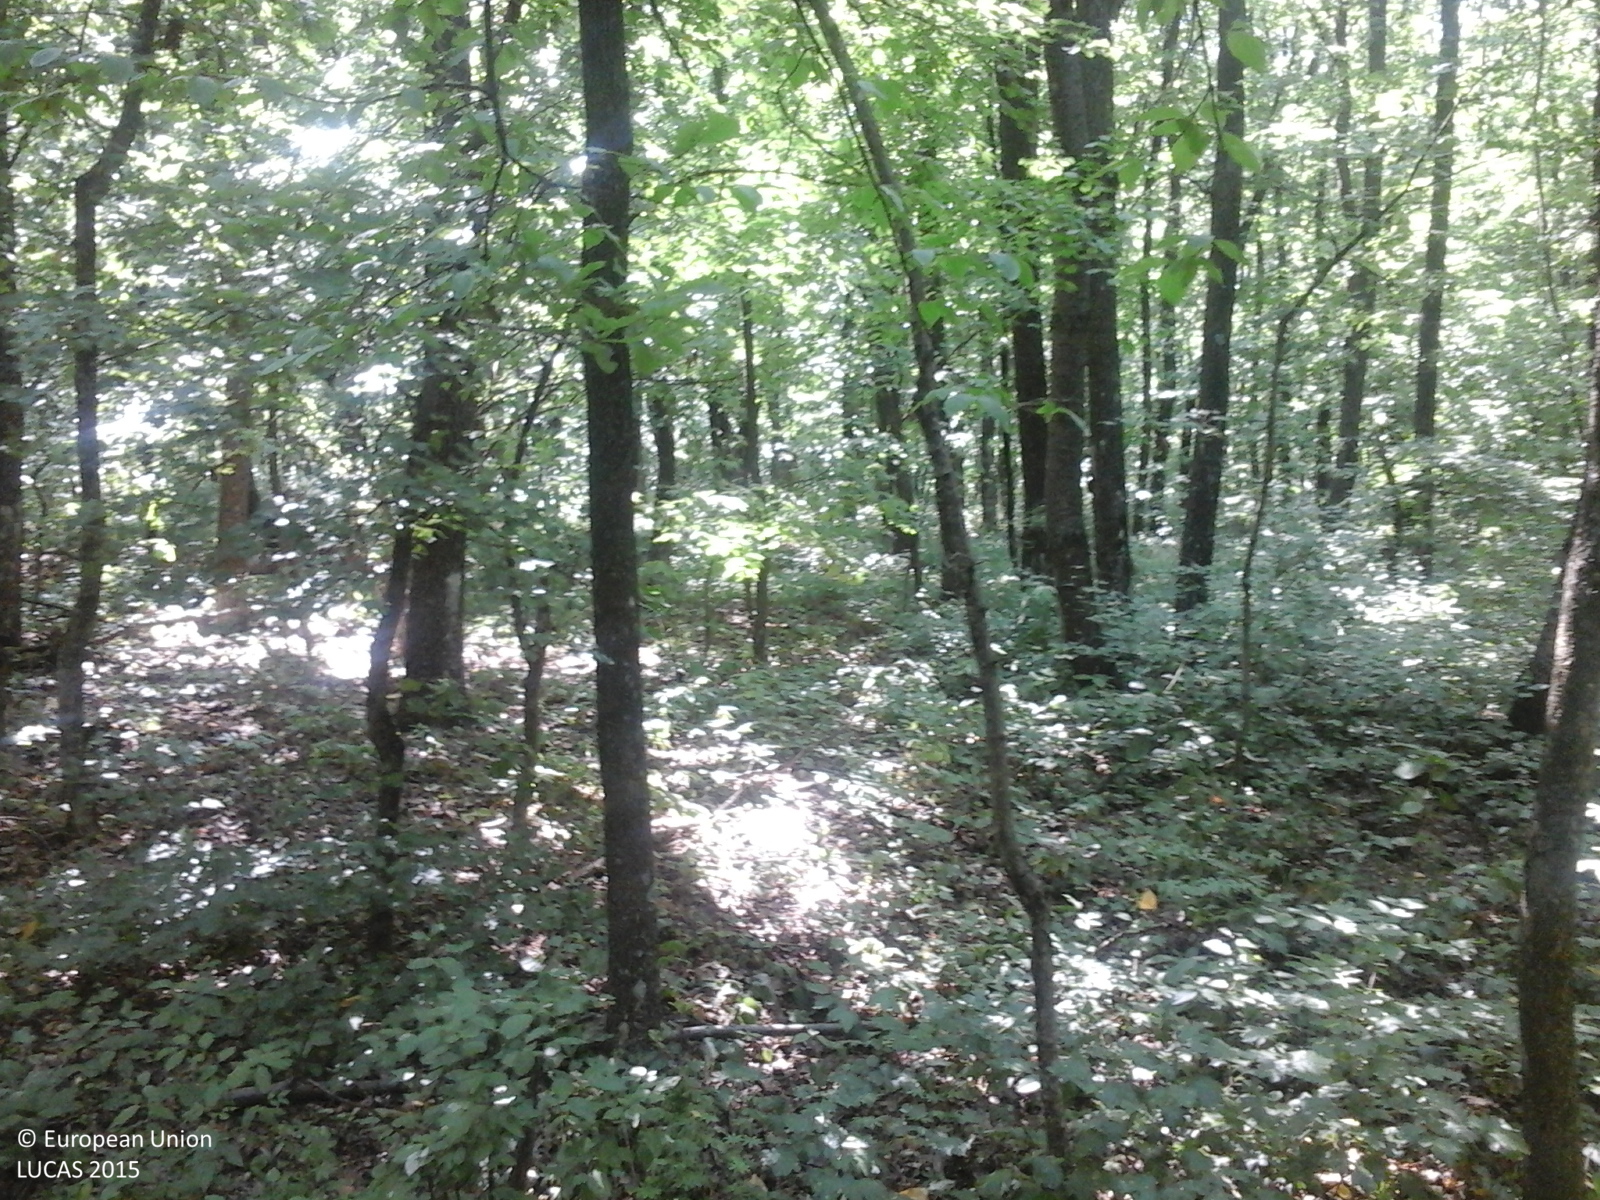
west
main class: Woodland
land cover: Broadleaved woodland
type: beech forest
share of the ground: > 75 %
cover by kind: broadleaved forest trees 90 %, herbaceous plants 10 %
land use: Forestry
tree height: > 5 m
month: June
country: RO
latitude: 46.7271
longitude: 27.9886
